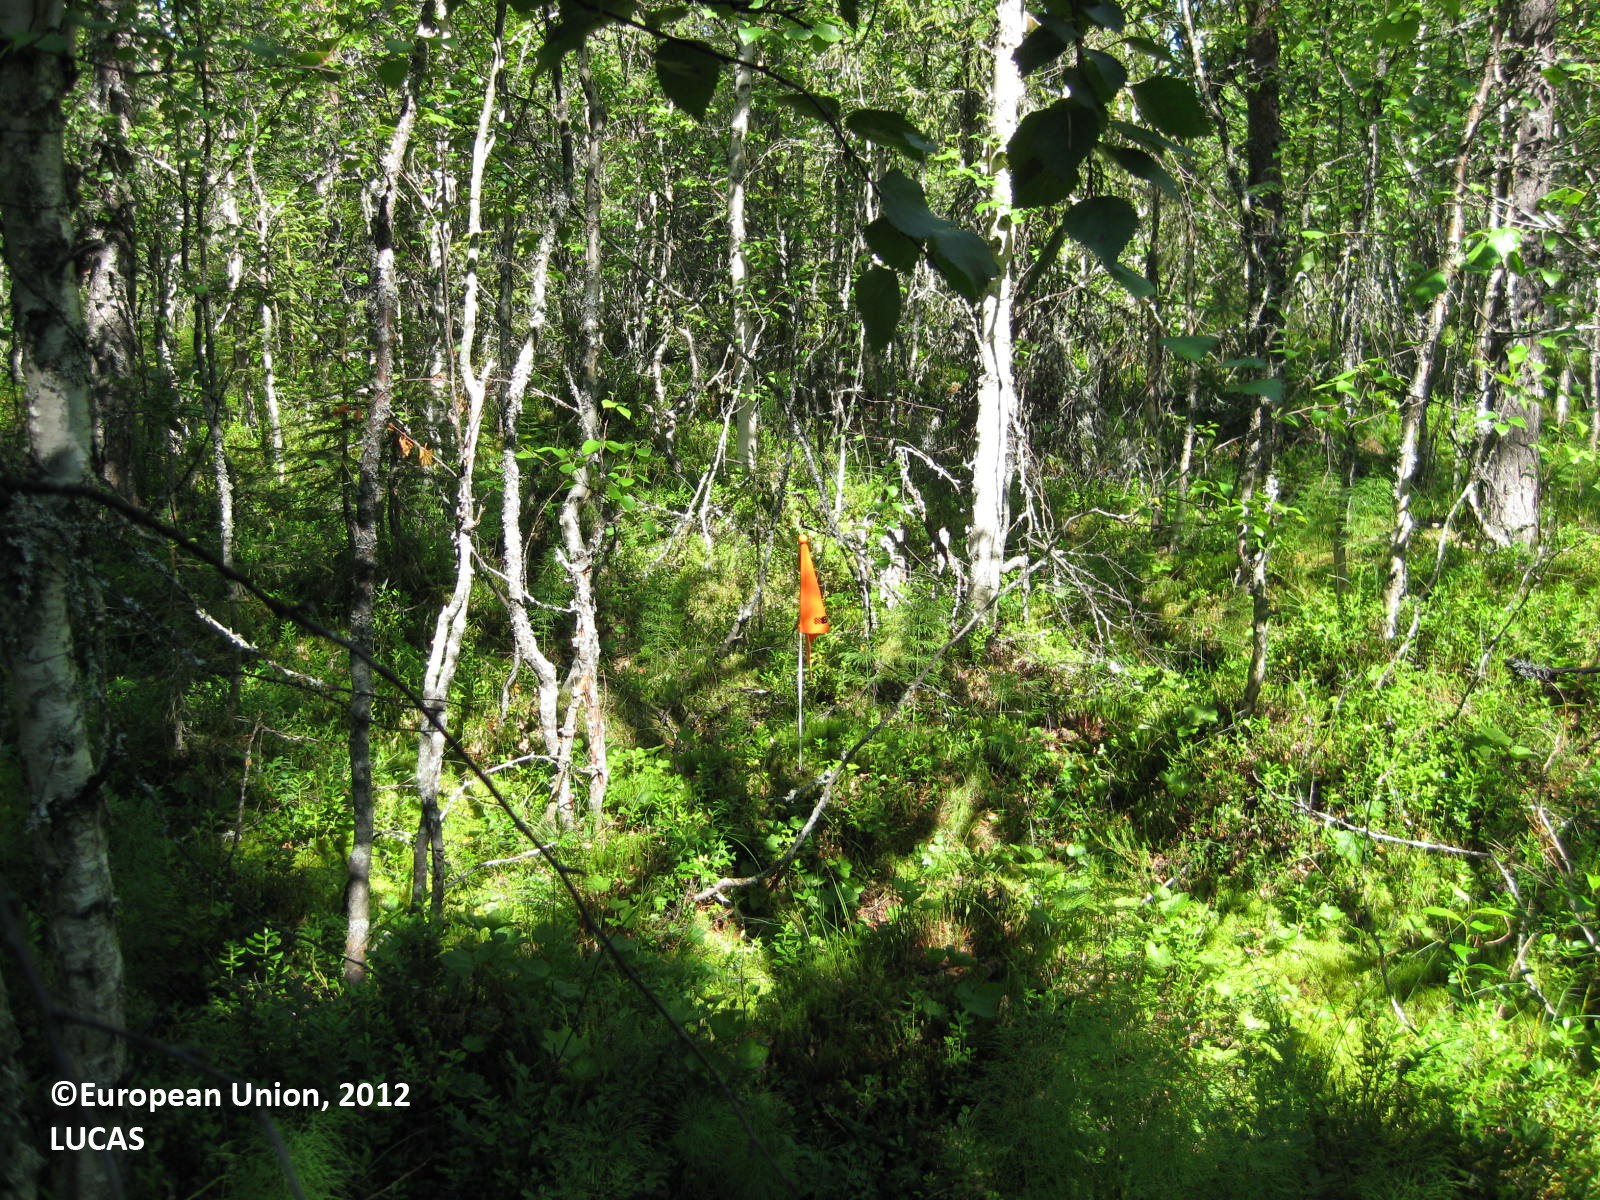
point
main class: Woodland
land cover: Pine dominated mixed woodland
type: boreal forest
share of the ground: > 75 %
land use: Forestry
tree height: > 5 m
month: July
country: FI
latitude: 65.6121
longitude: 28.5000
